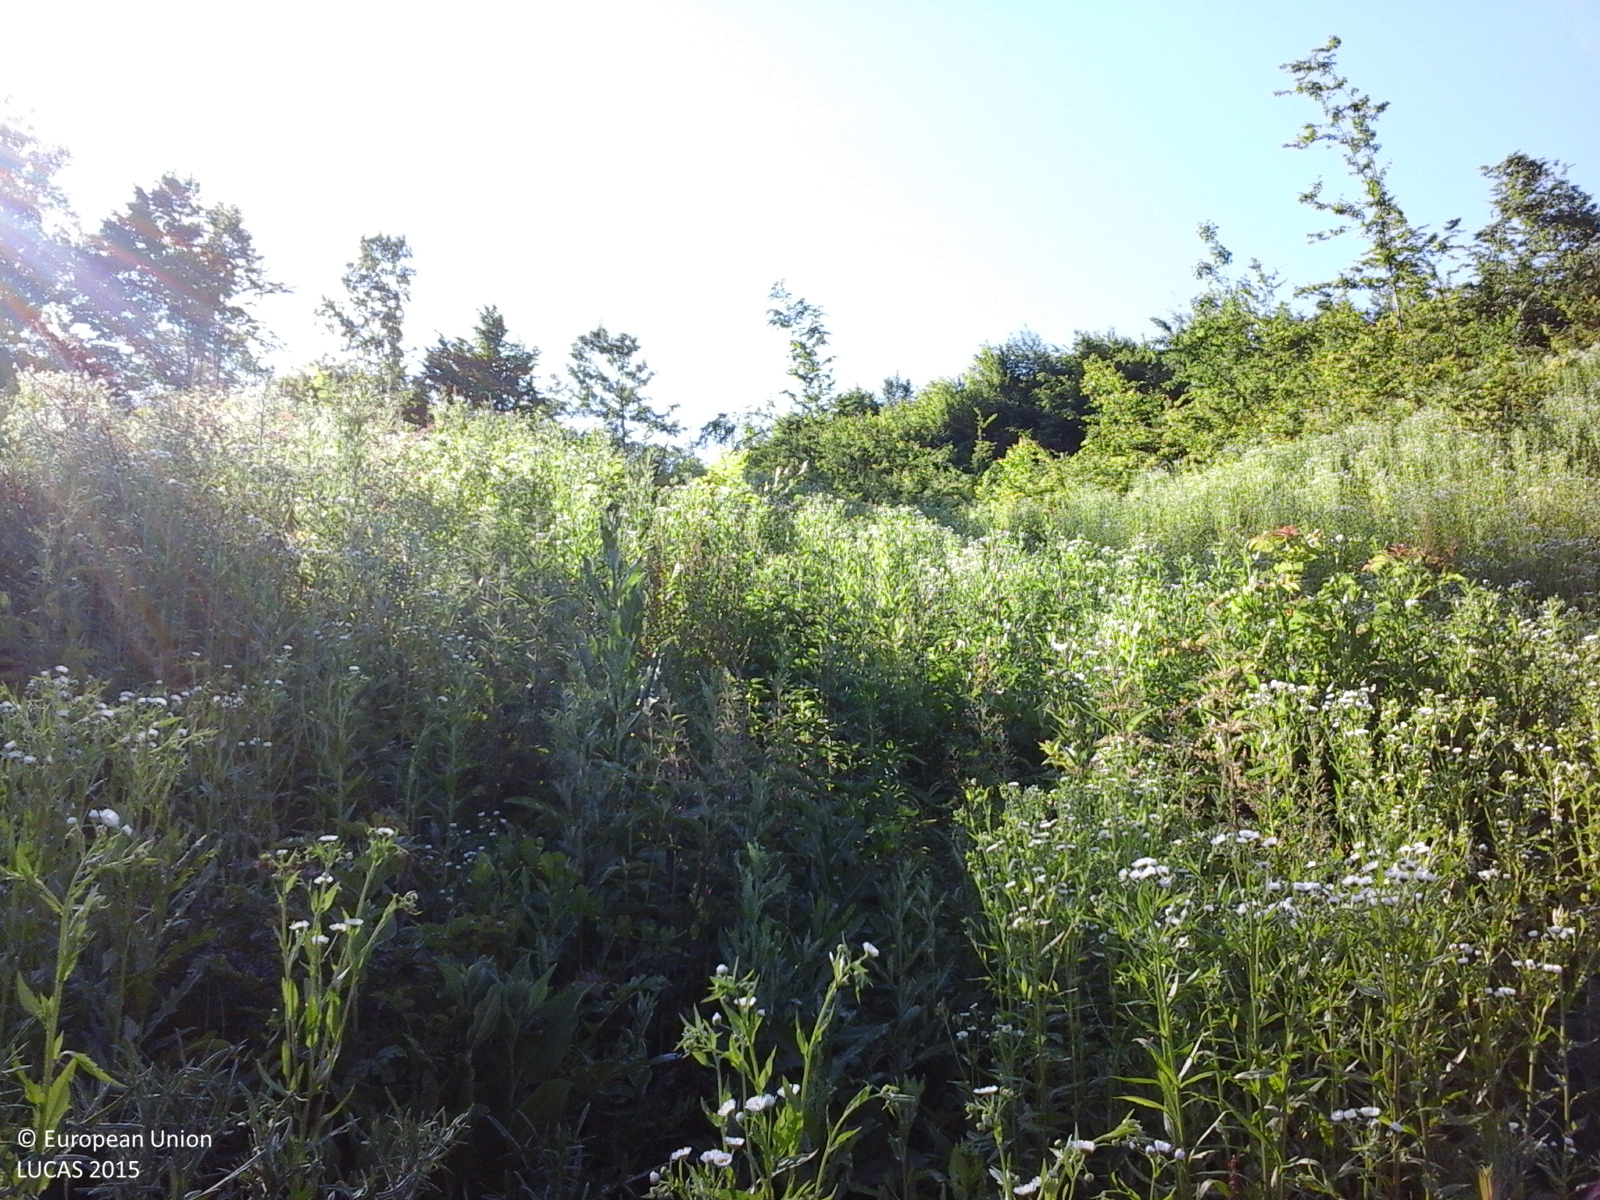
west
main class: Grassland
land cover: Spontaneously vegetated surfaces
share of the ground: > 75 %
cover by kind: herbaceous plants 100 %
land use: Forestry
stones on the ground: < 10 %
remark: Clear cut
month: June
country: RO
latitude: 45.1083
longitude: 25.8271
